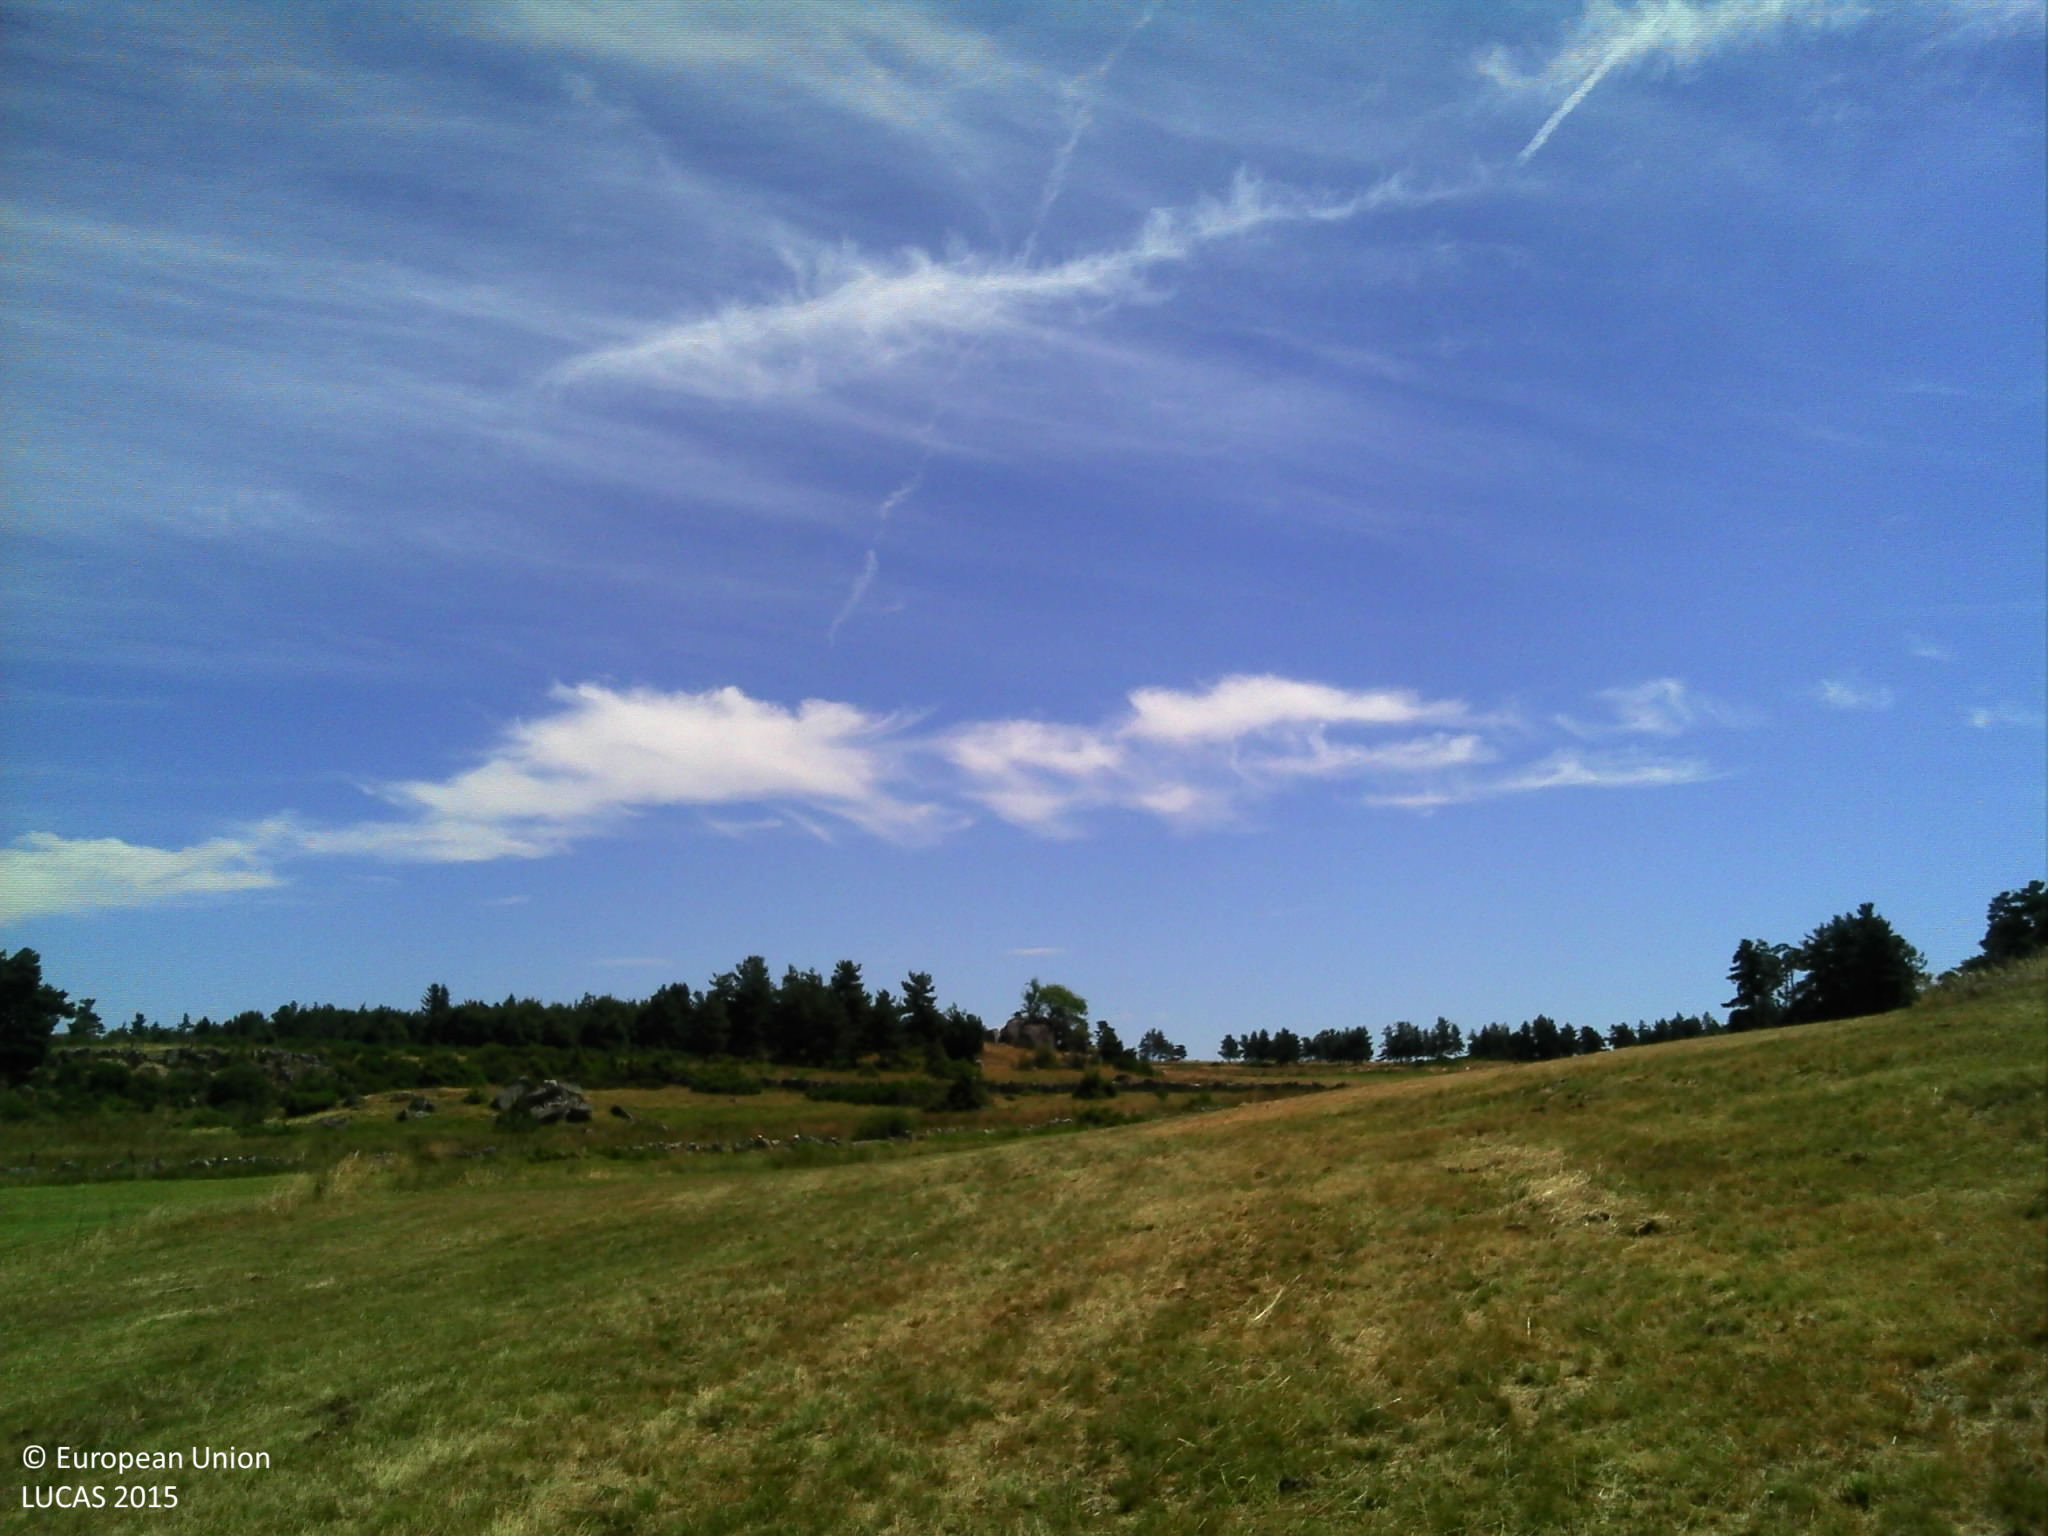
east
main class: Grassland
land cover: Grassland without tree/shrub cover
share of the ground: > 75 %
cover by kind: herbaceous plants 100 %
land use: Agriculture (excluding fallow land and kitchen gardens)
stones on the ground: 10 - 25 %
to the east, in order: Grassland without tree/shrub cover; Fences; Dry stone walls; Grassland without tree/shrub cover; Dry stone walls; Fences; Temporary grasslands
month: July
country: FR
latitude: 44.6868
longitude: 3.1778
